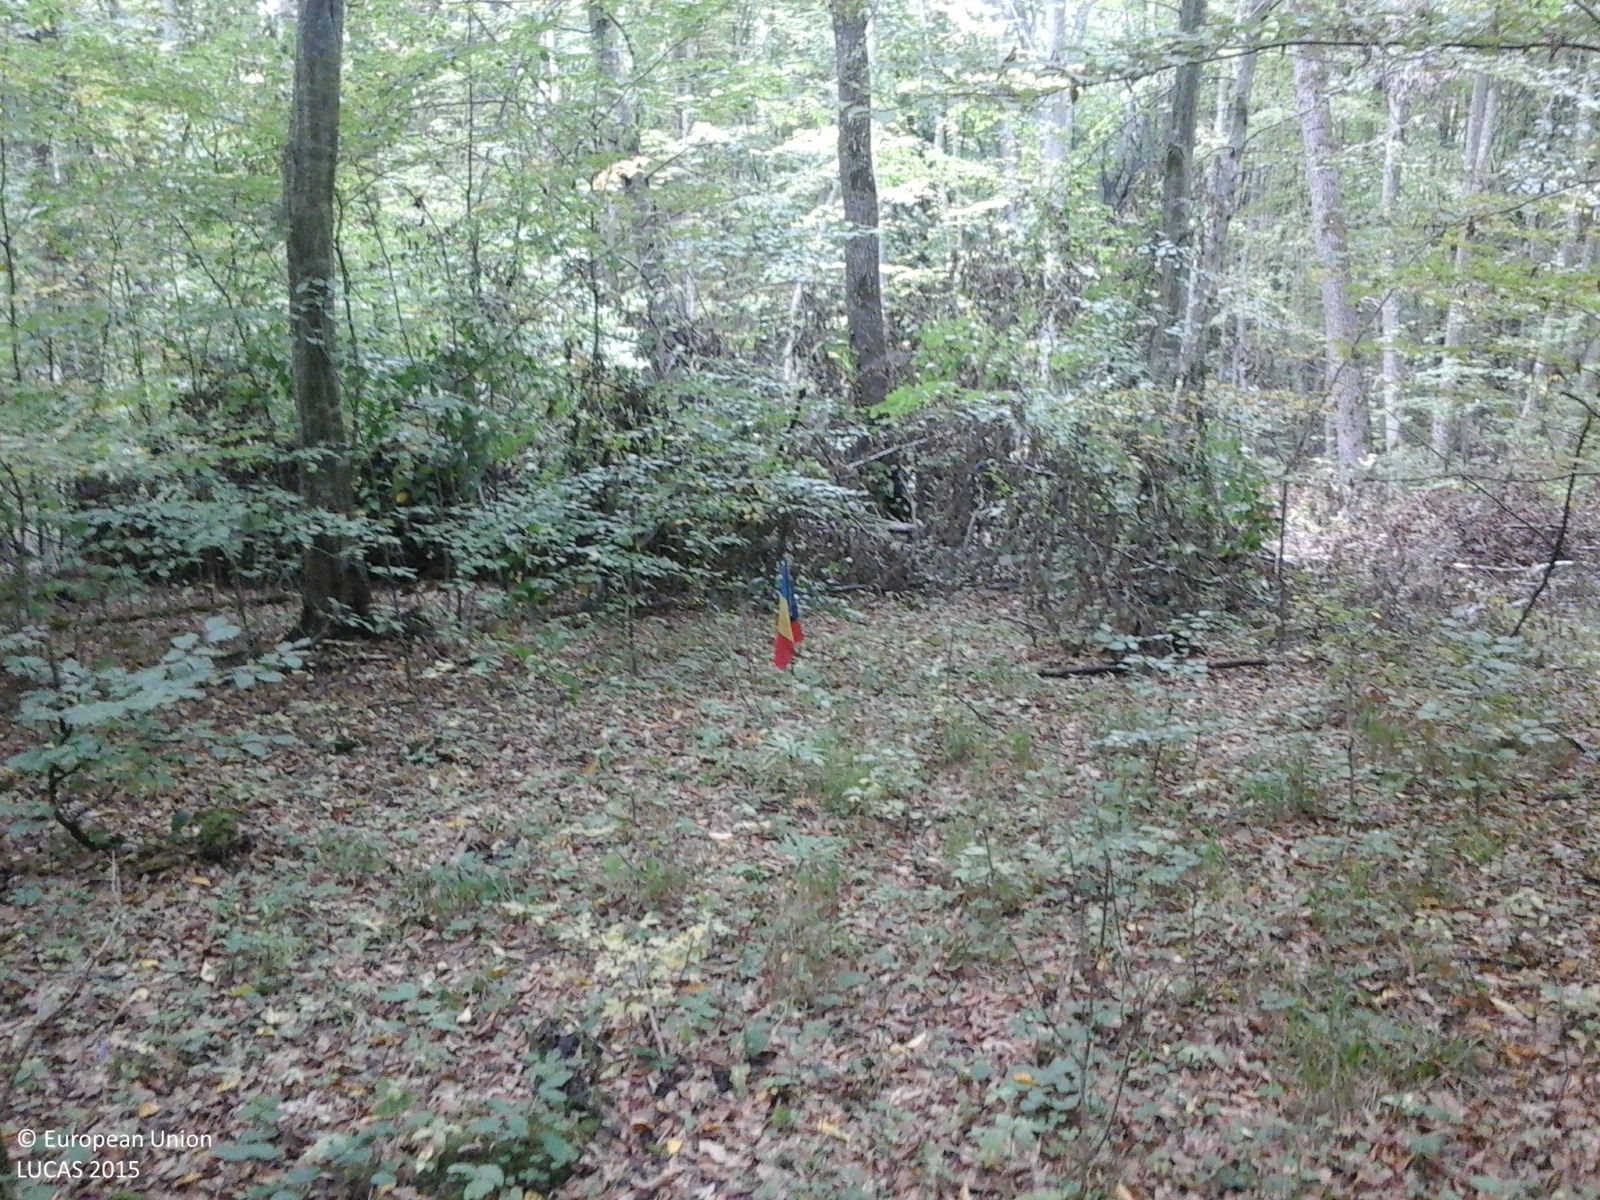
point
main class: Woodland
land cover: Broadleaved woodland
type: beech forest
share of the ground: > 75 %
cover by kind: broadleaved forest trees 100 %
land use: Forestry
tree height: > 5 m
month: October
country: RO
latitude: 46.0429
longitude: 25.3371
